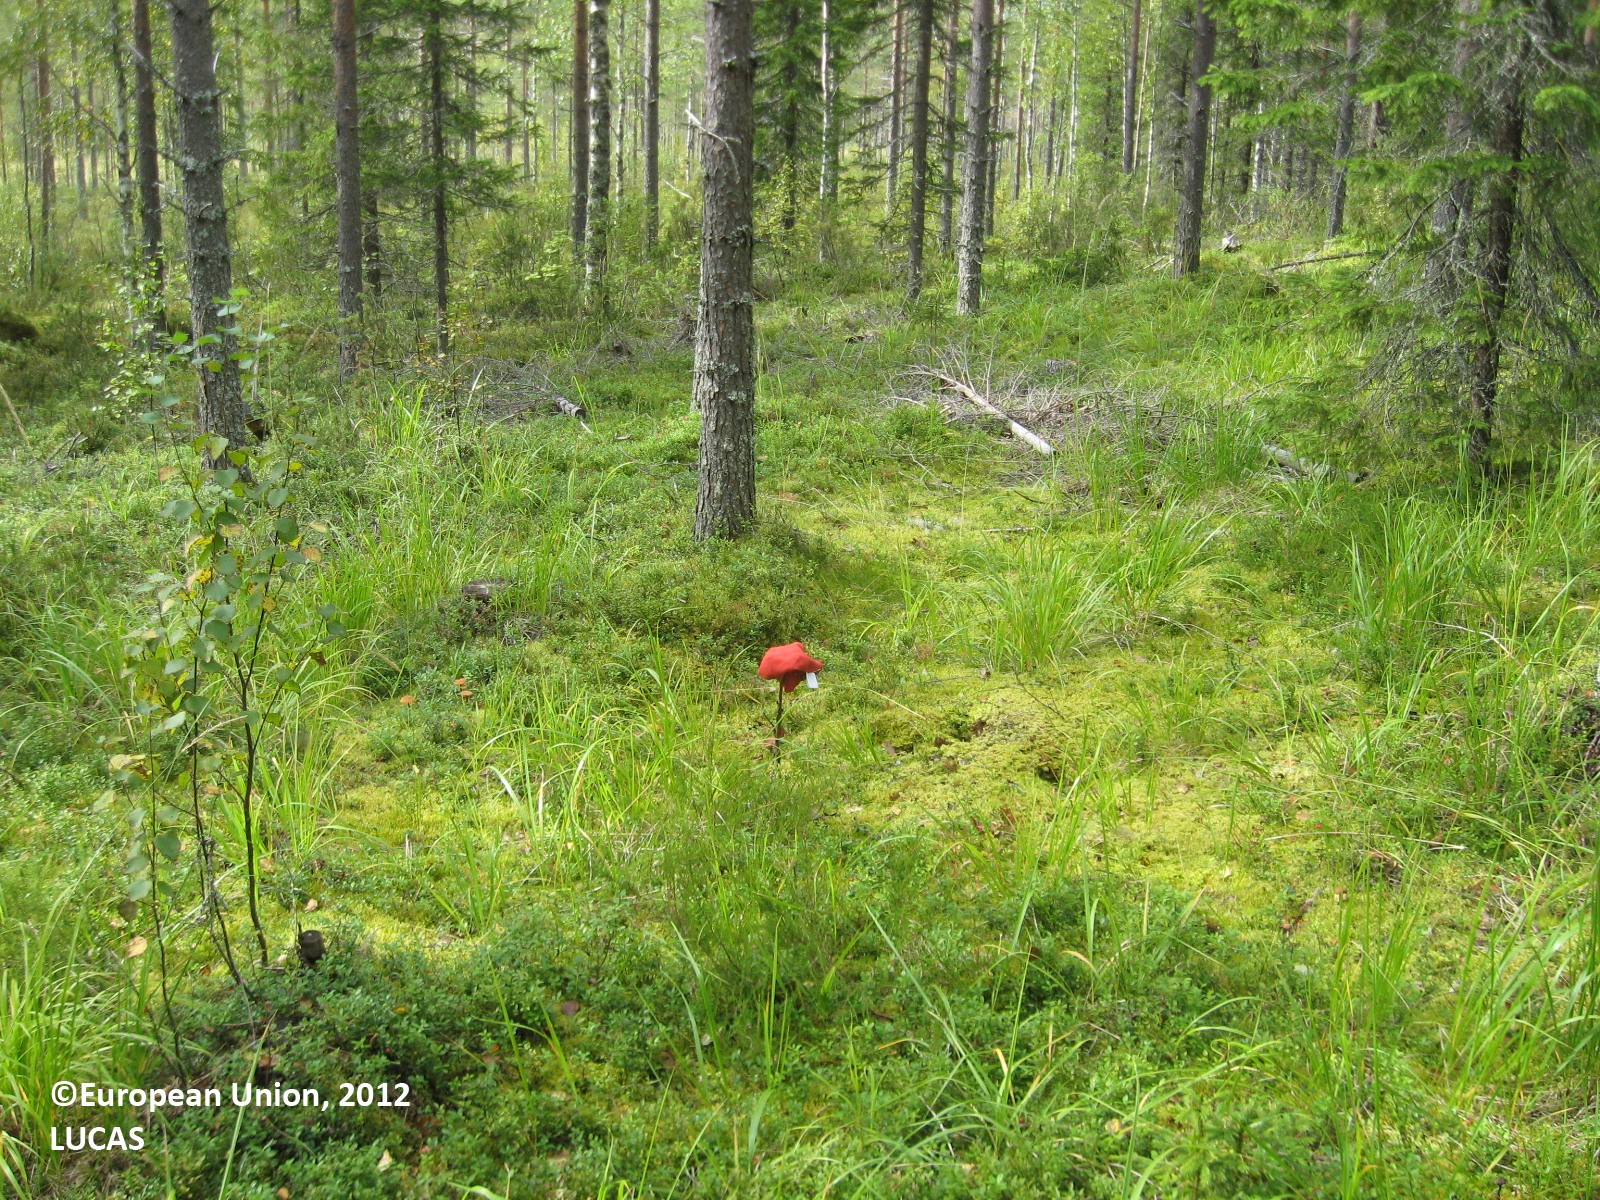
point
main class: Woodland
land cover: Pine dominated coniferous woodland
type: boreal forest
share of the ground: 50 - 75 %
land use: Forestry
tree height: > 5 m
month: August
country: FI
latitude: 63.7762
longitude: 29.1339
